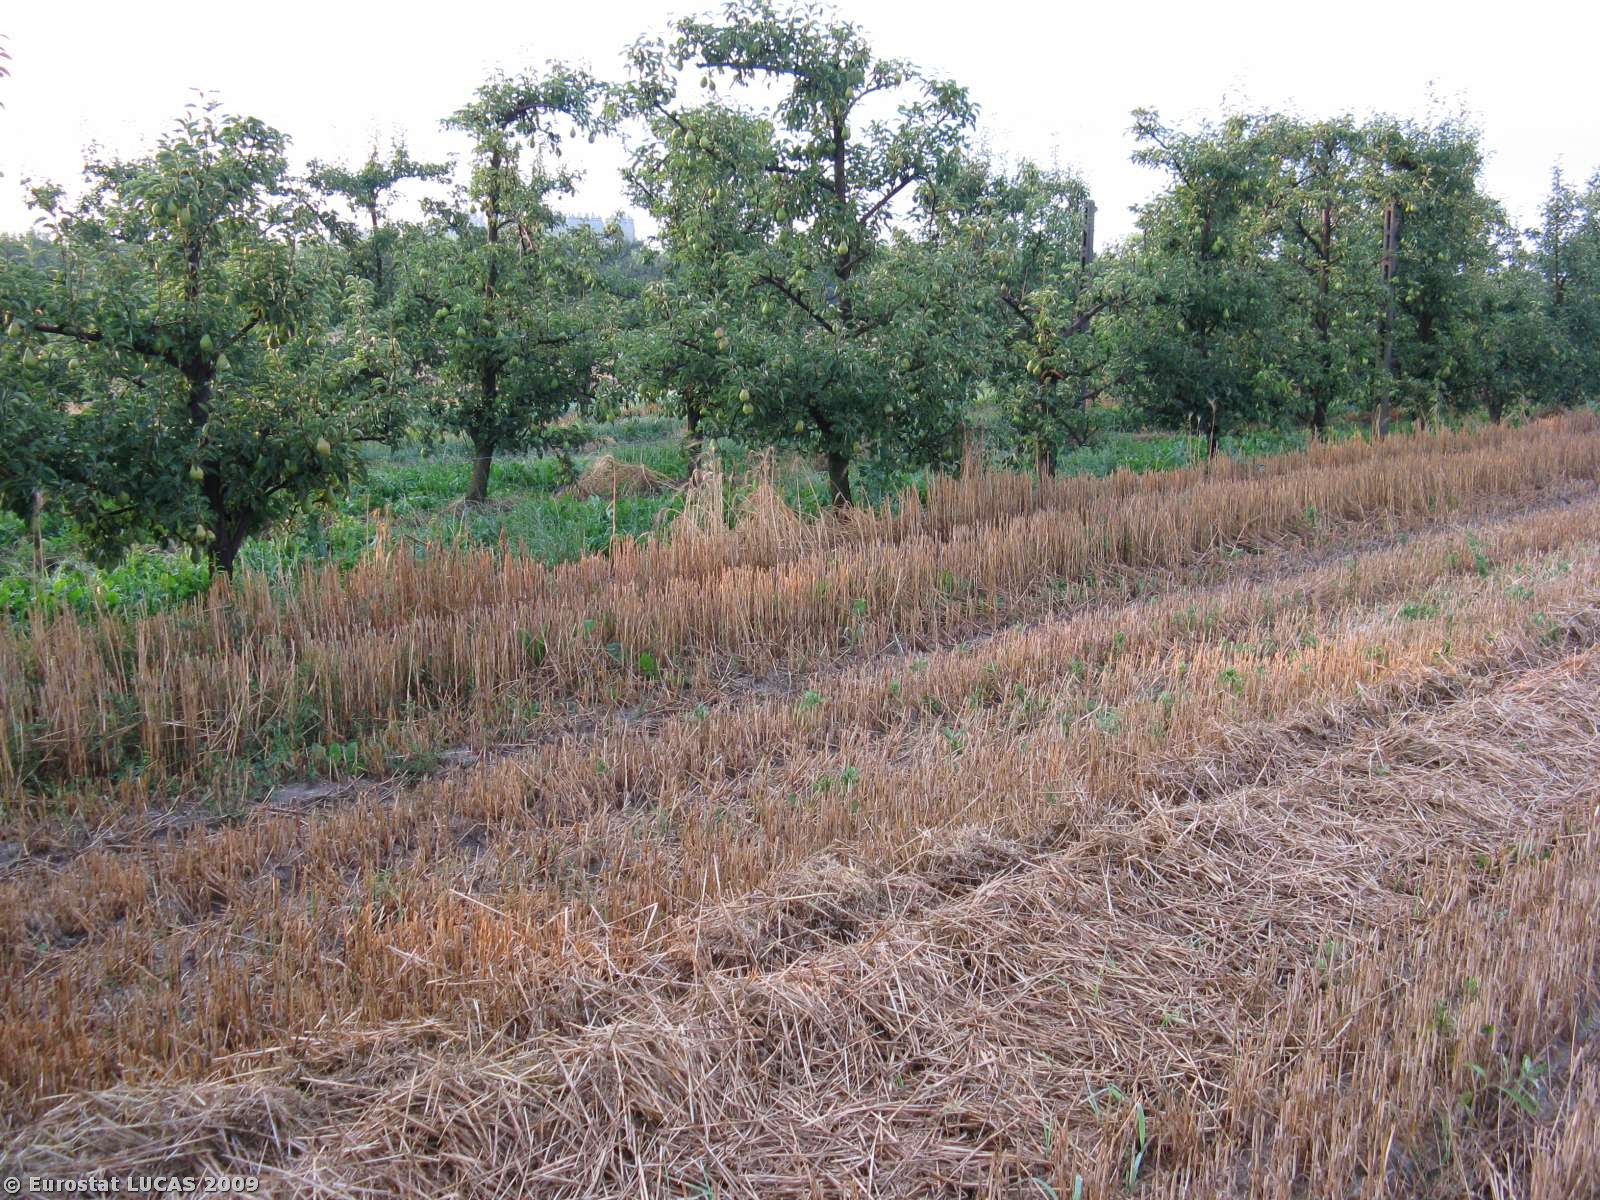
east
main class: Cropland
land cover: Common wheat
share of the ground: < 10 %
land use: Agriculture (excluding fallow land and kitchen gardens)
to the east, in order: Common wheat; Pear fruit; Grassland with sparse tree/shrub cover; Common wheat; Pear fruit; Grassland with sparse tree/shrub cover; Common wheat; Ditches and canals; Common wheat; Electric lines; Common wheat
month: July
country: IT
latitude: 44.7883
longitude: 11.6525
